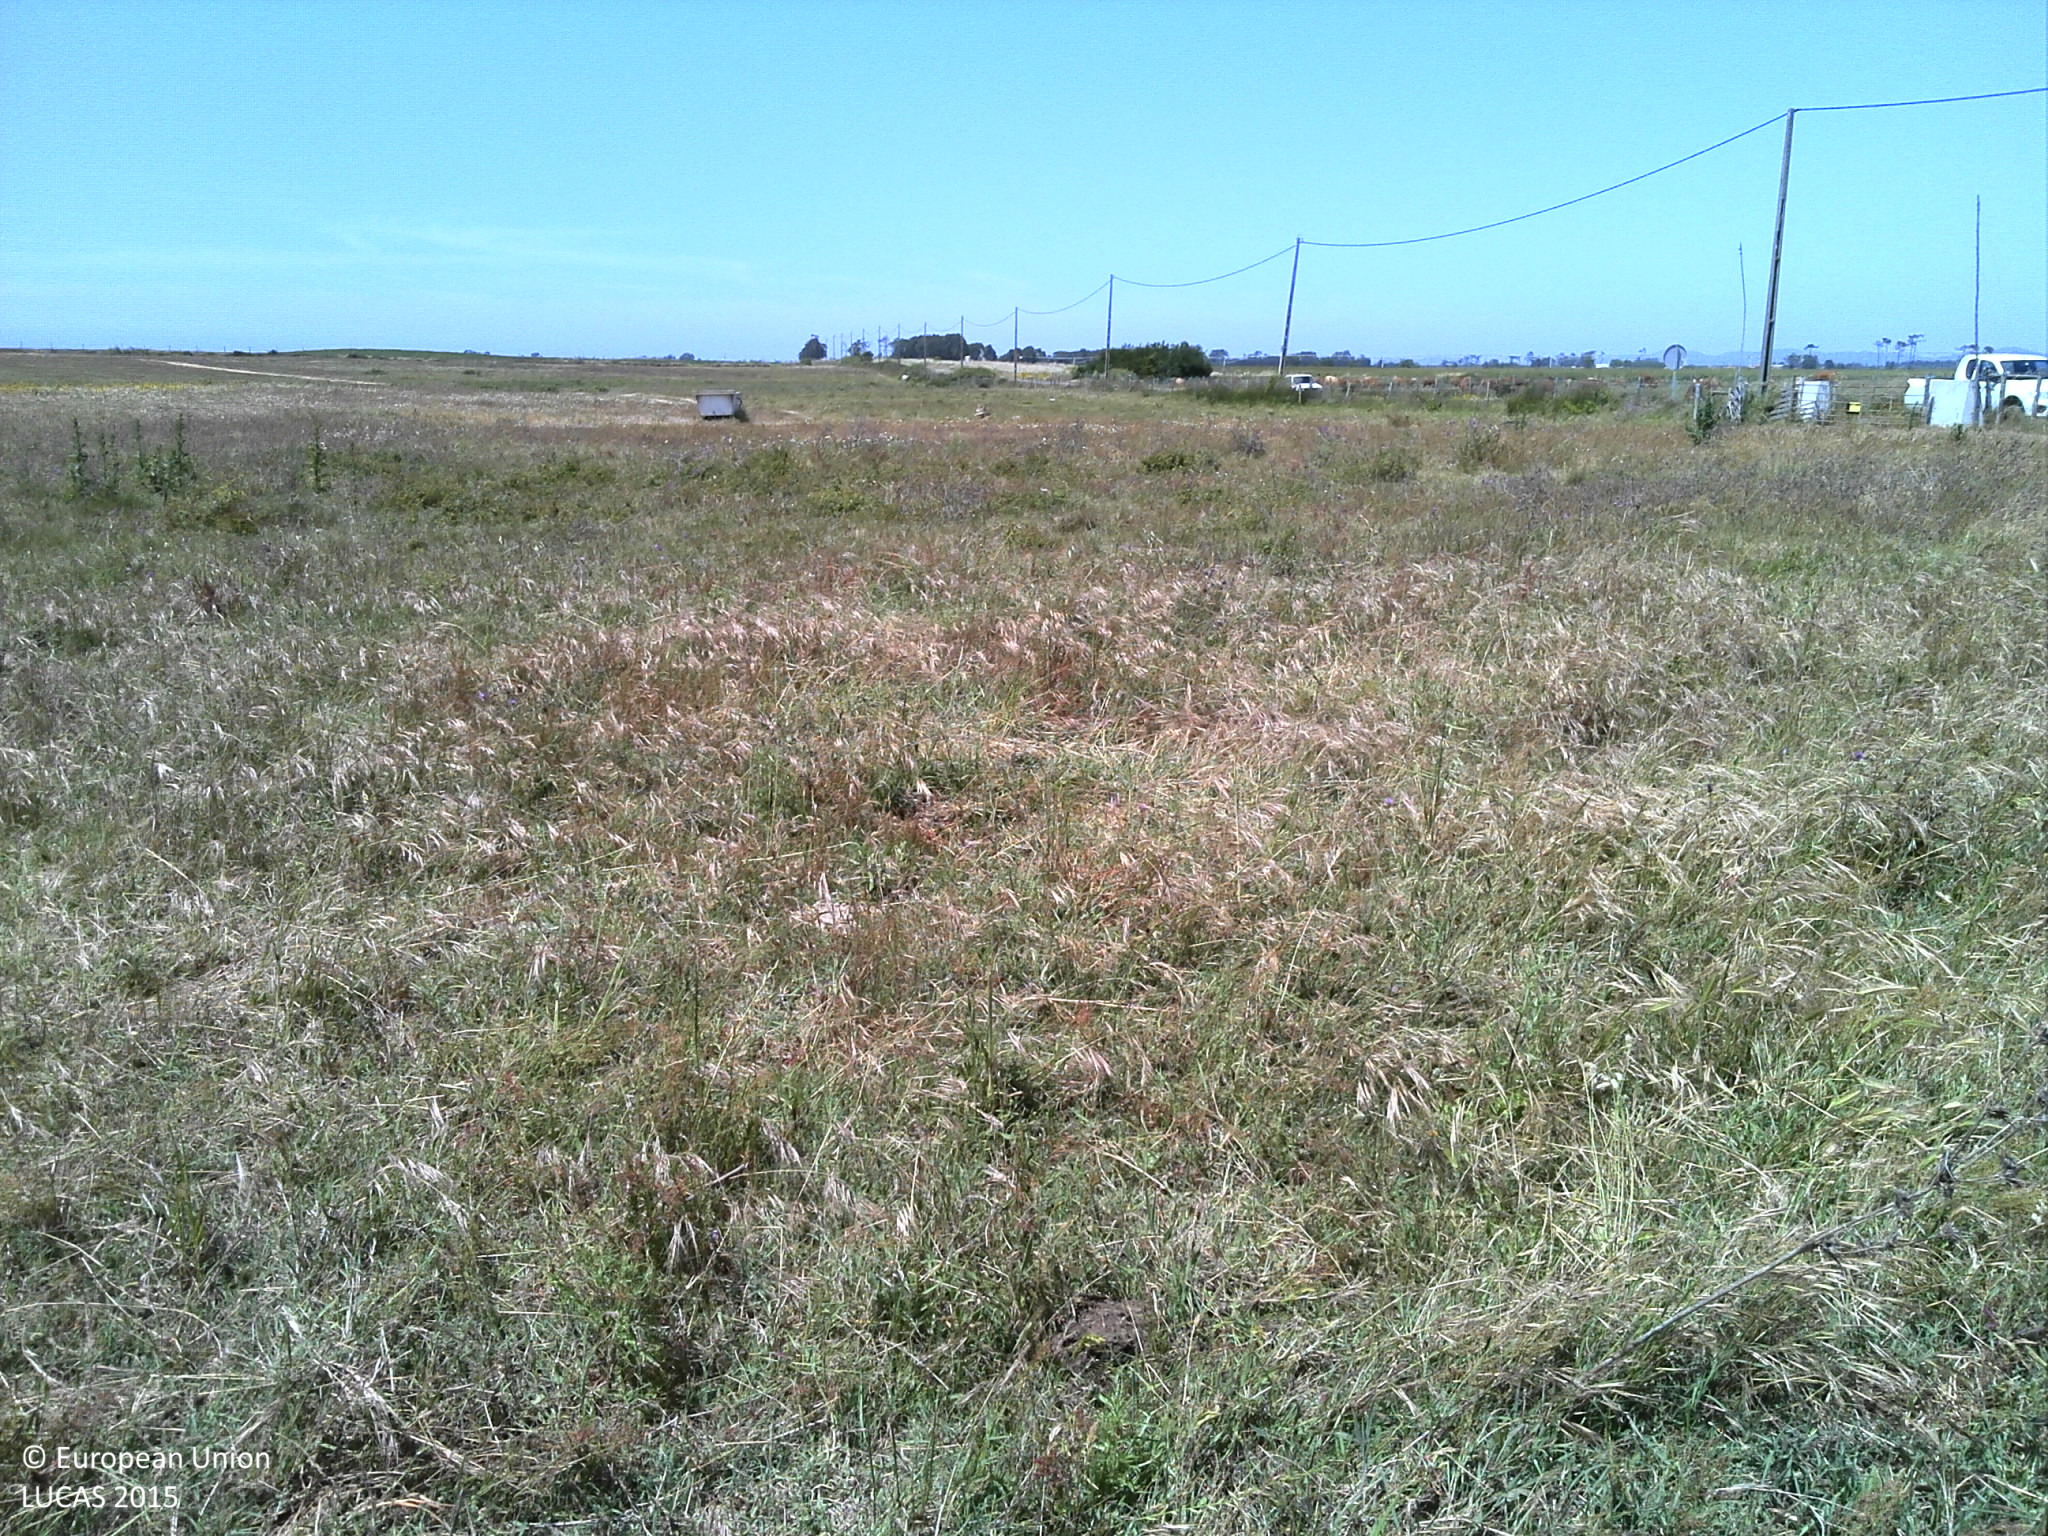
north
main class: Grassland
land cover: Grassland without tree/shrub cover
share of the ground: > 75 %
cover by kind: herbaceous plants 80 %, consolidated bare surface 15 %, shrubs 5 %
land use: Agriculture (excluding fallow land and kitchen gardens)
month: May
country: PT
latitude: 37.5649
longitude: -8.7778
